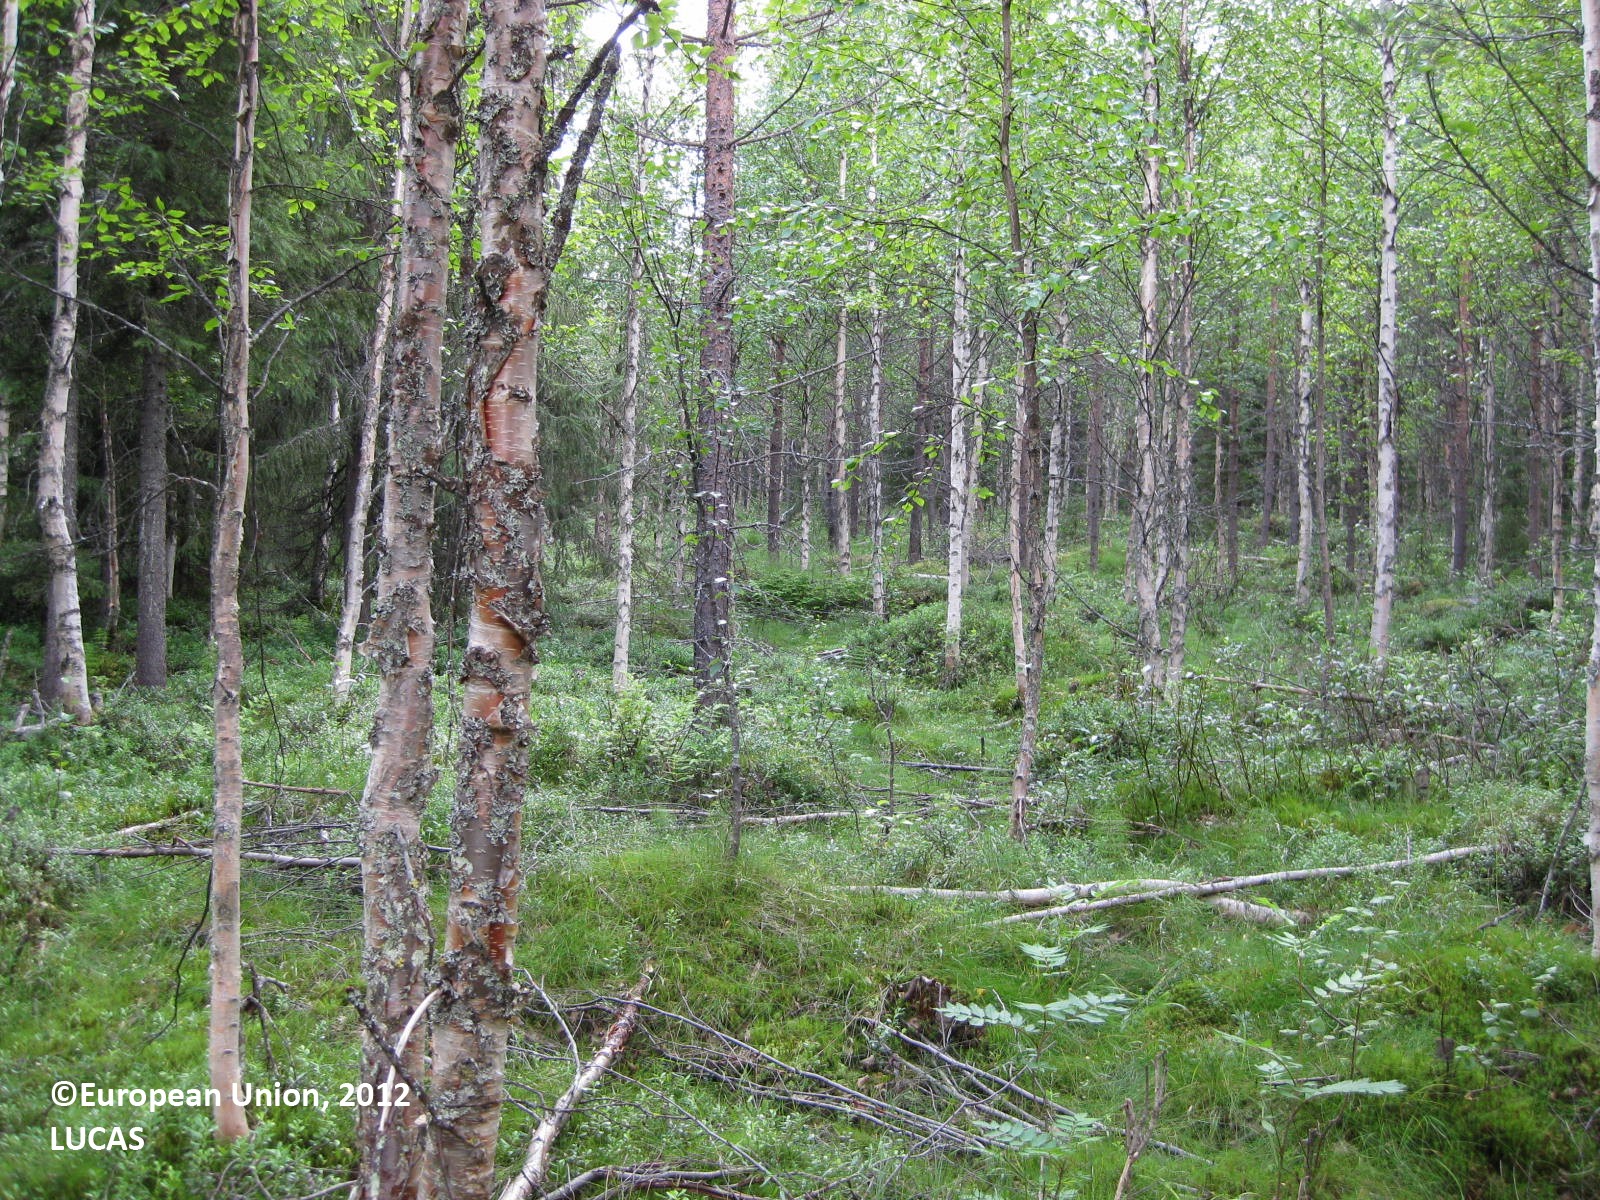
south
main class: Woodland
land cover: Other mixed woodland
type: boreal forest
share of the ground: > 75 %
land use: Forestry
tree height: > 5 m
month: July
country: FI
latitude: 65.6861
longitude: 28.5079
